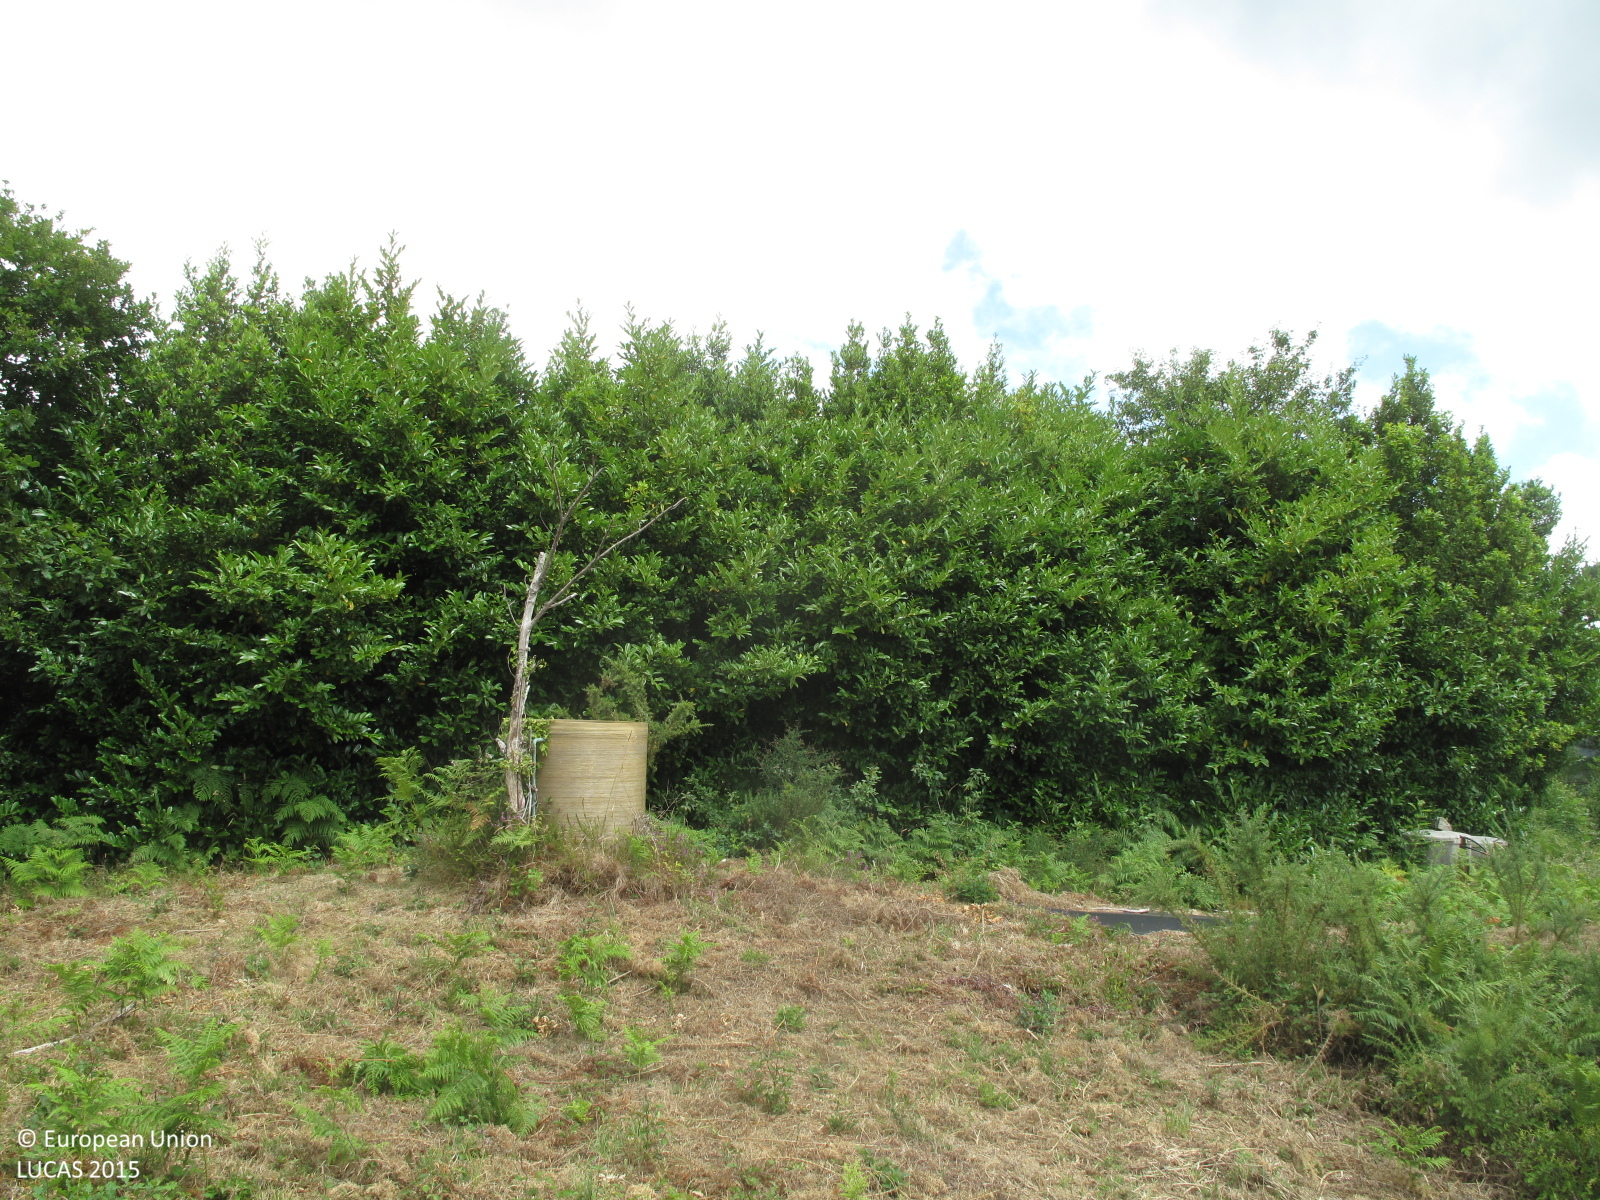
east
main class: Shrubland
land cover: Shrubland with sparse tree cover
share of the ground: 10 - 25 %
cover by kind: herbaceous plants 80 %, shrubs 10 %, broadleaved forest trees 5 %, unconsolidated bare surface 5 %
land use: Semi-natural and natural areas not in use
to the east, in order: Shrubland with sparse tree cover; Abandoned hedges; Artificial constructions in urban areas; Grassland without tree/shrub cover; Broadleaved woodland; Paved roads, cycling and walking lanes; Pine dominated mixed woodland; Broadleaved woodland
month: July
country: ES
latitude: 43.4956
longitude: -8.0157
